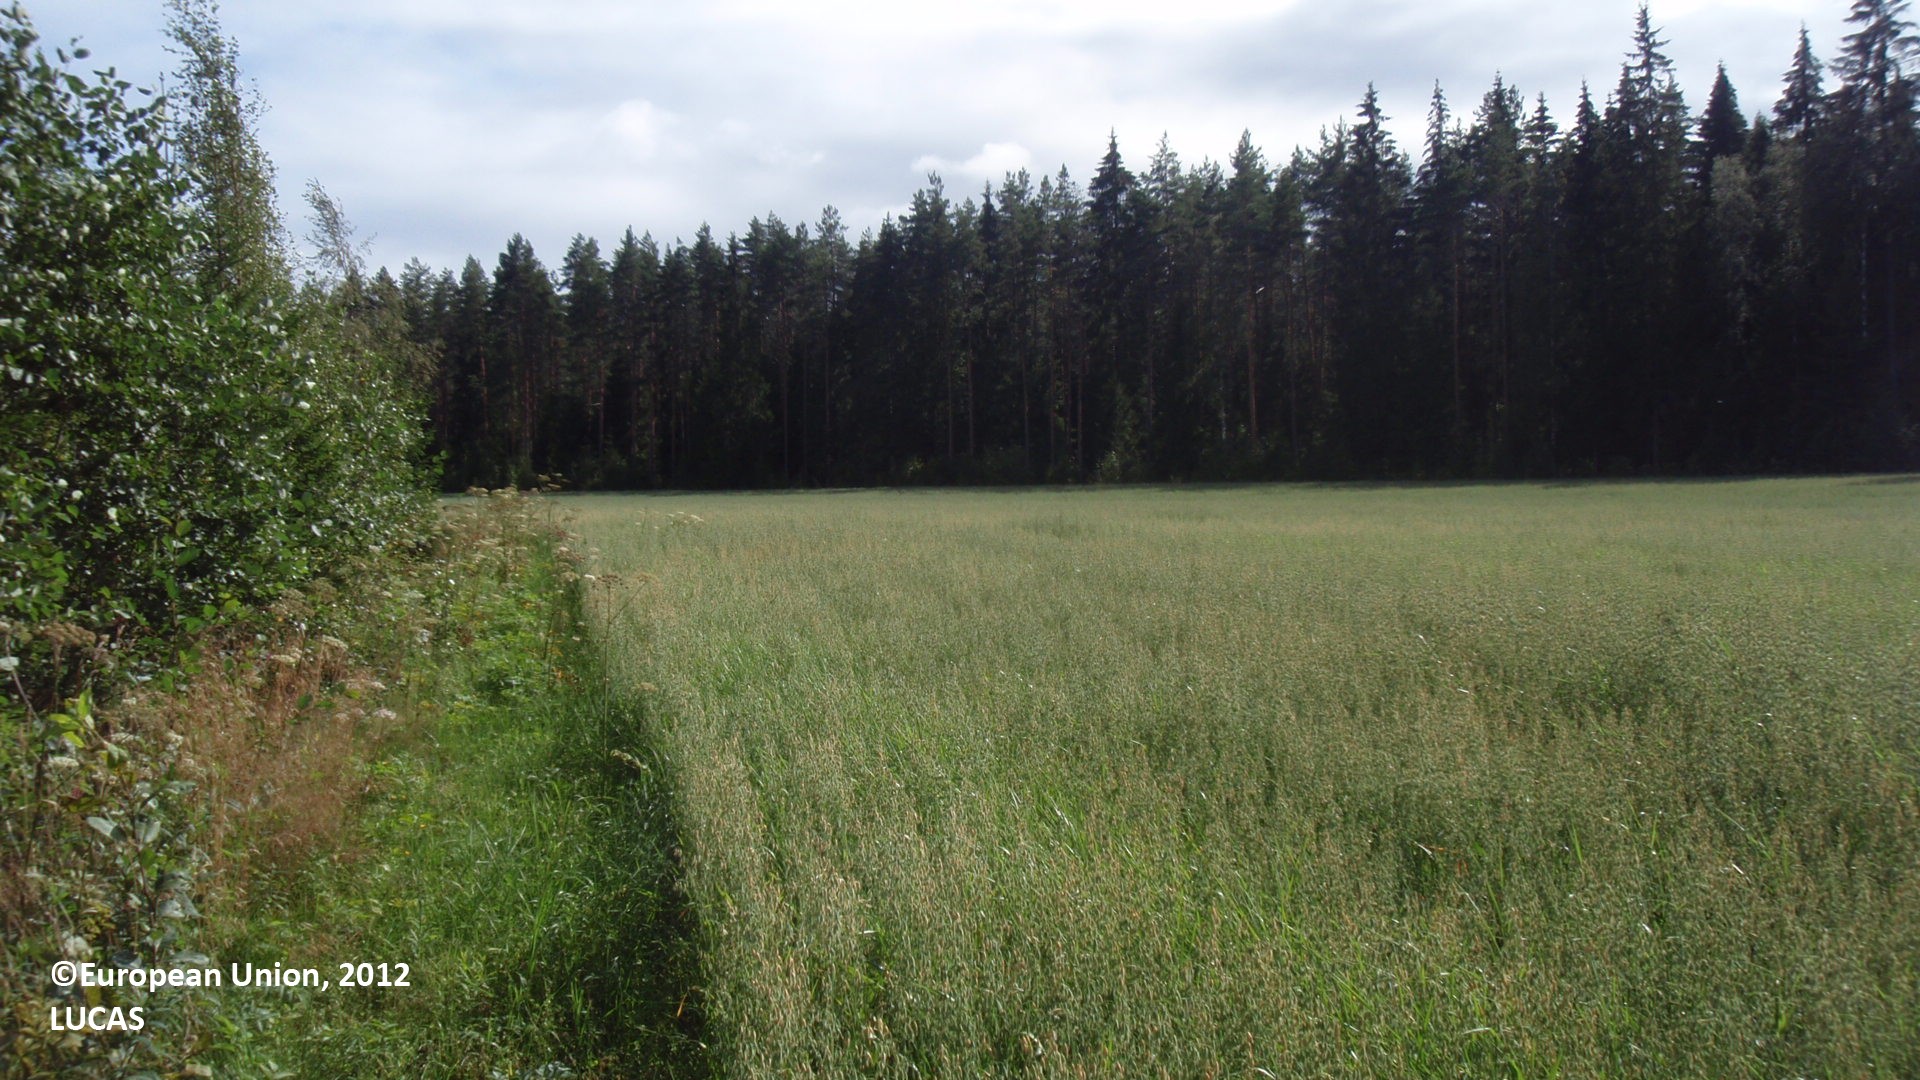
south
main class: Cropland
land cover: Oats
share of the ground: > 75 %
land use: Agriculture (excluding fallow land and kitchen gardens)
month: August
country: FI
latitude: 61.0506
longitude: 27.0775
